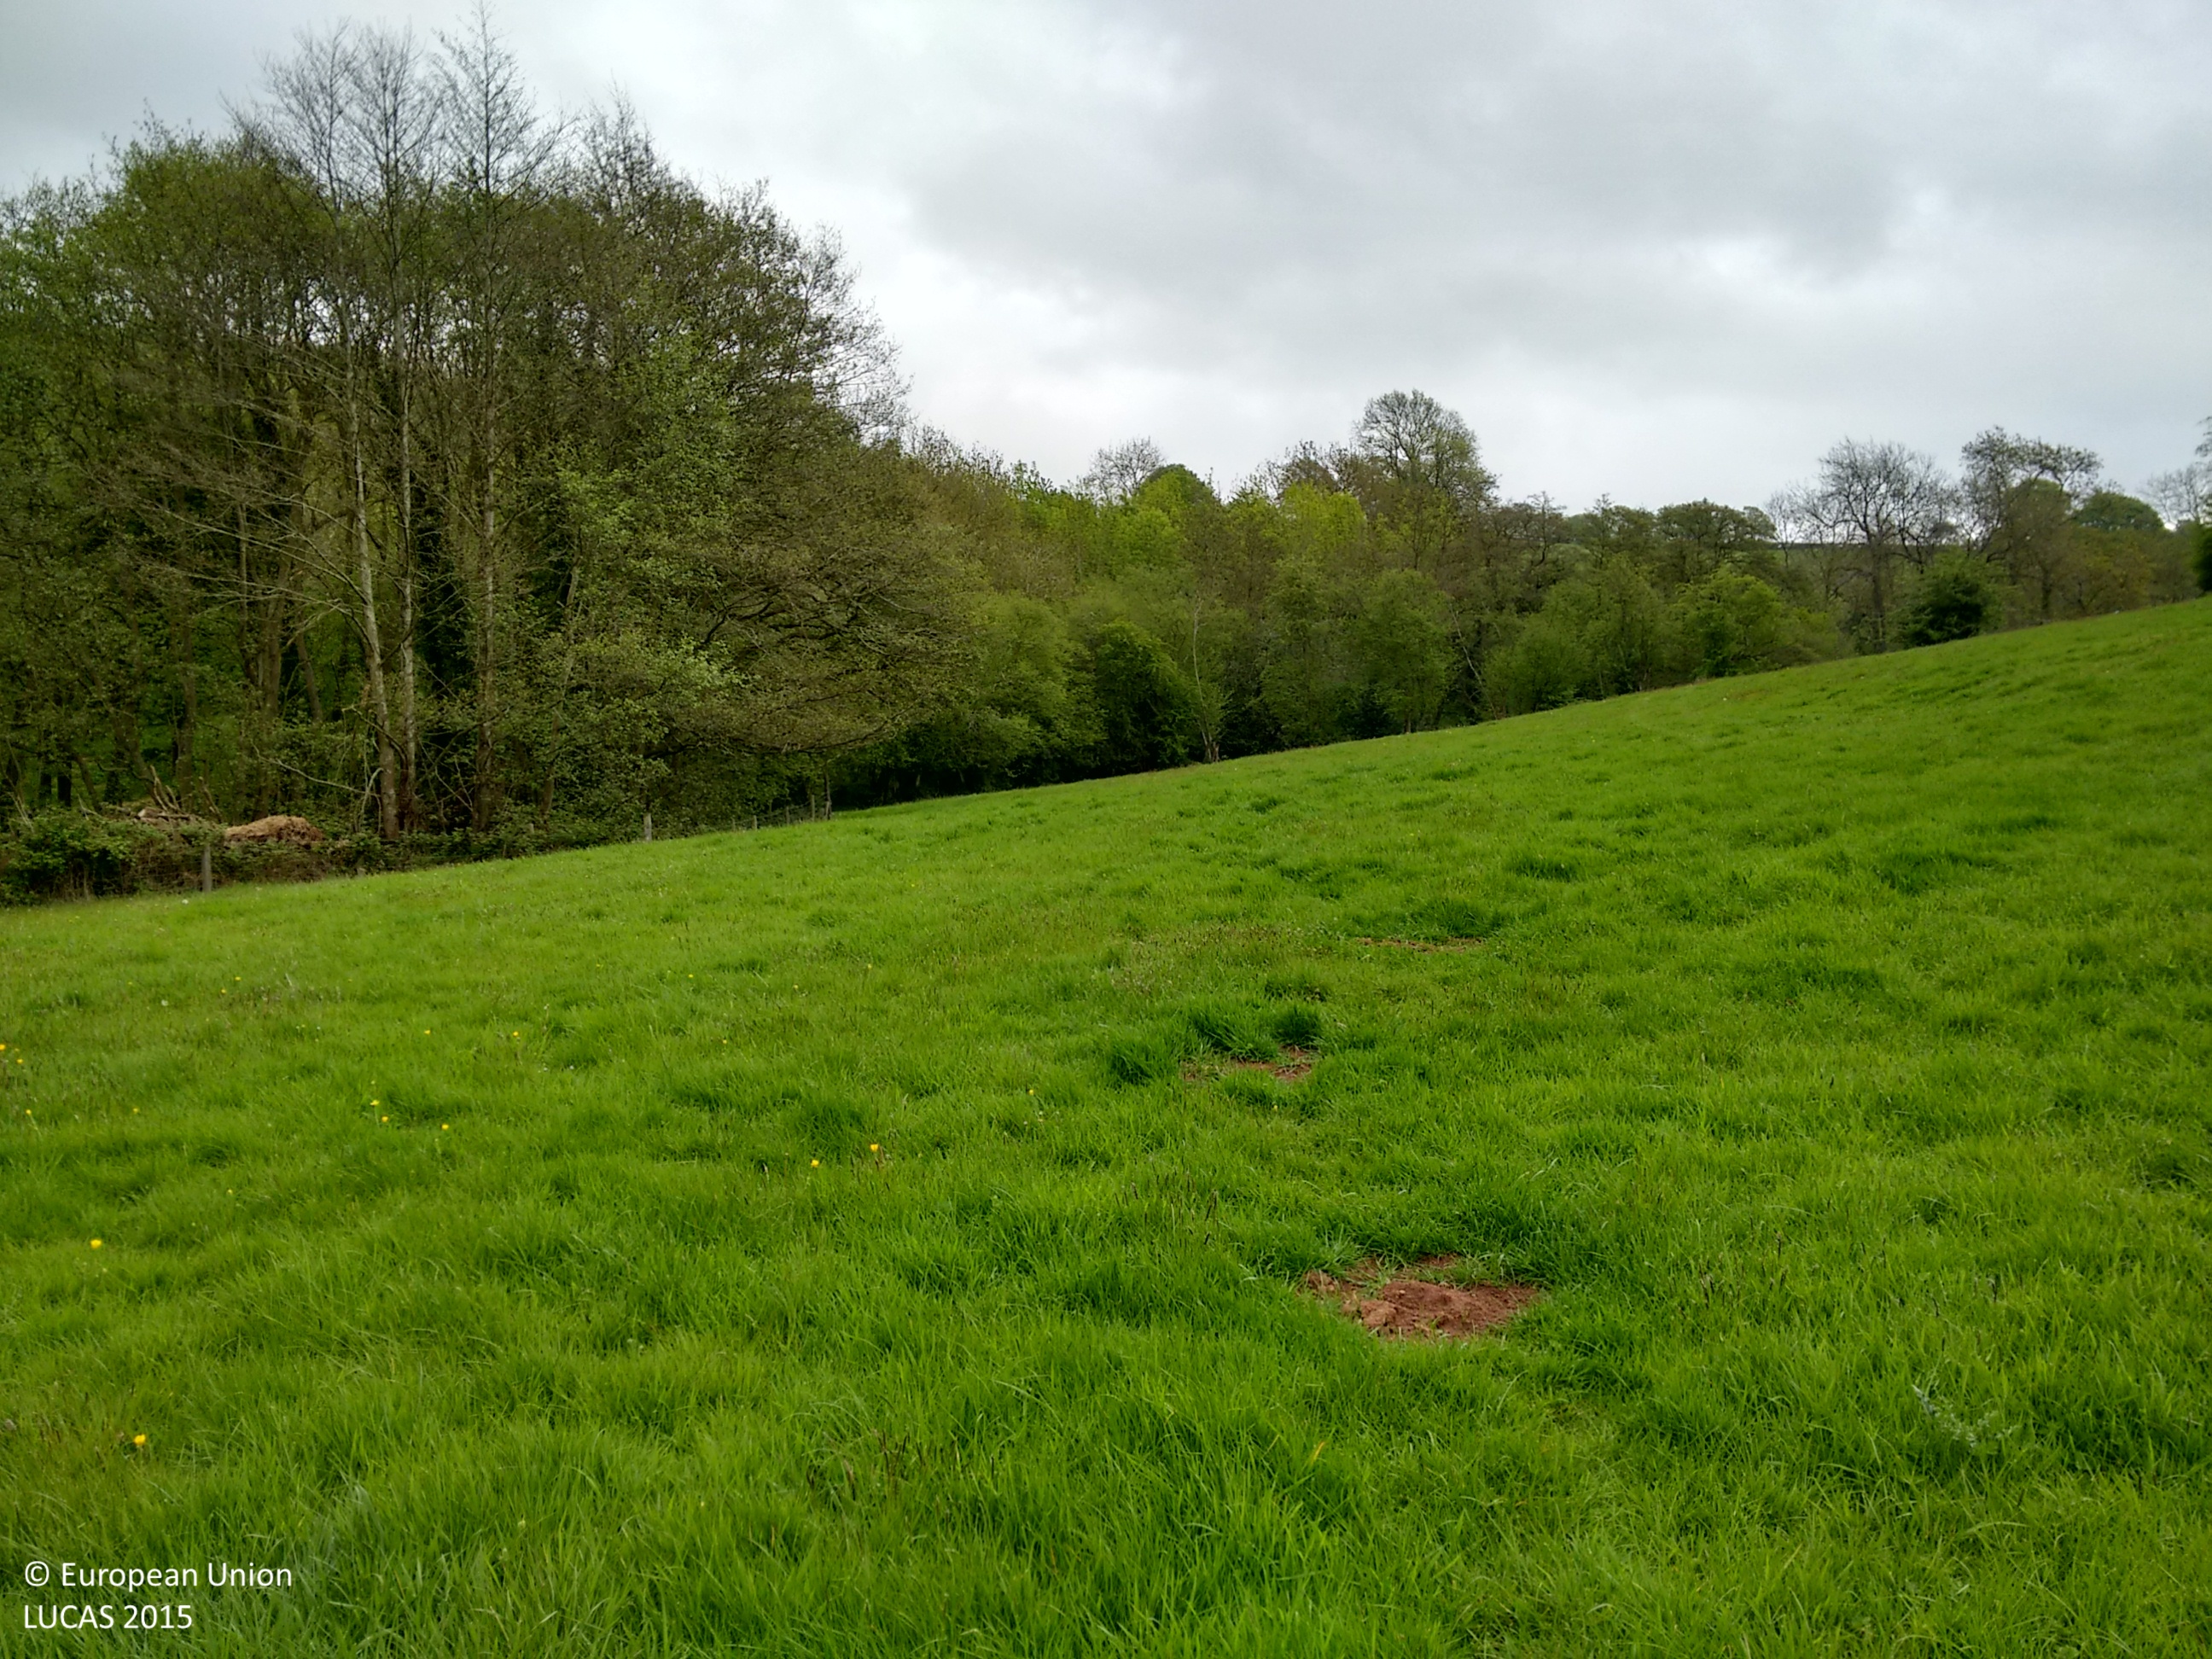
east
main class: Grassland
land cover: Grassland without tree/shrub cover
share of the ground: > 75 %
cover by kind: herbaceous plants 100 %
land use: Agriculture (excluding fallow land and kitchen gardens)
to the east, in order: Grassland without tree/shrub cover; Fences; Broadleaved woodland; Rivers and streams; Broadleaved woodland; Tracks; Broadleaved woodland; Tracks; Grass margins; Managed hedges; Fences; Grassland without tree/shrub cover; Tracks; Broadleaved woodland
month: May
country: GB
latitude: 52.2974
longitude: -2.4860
